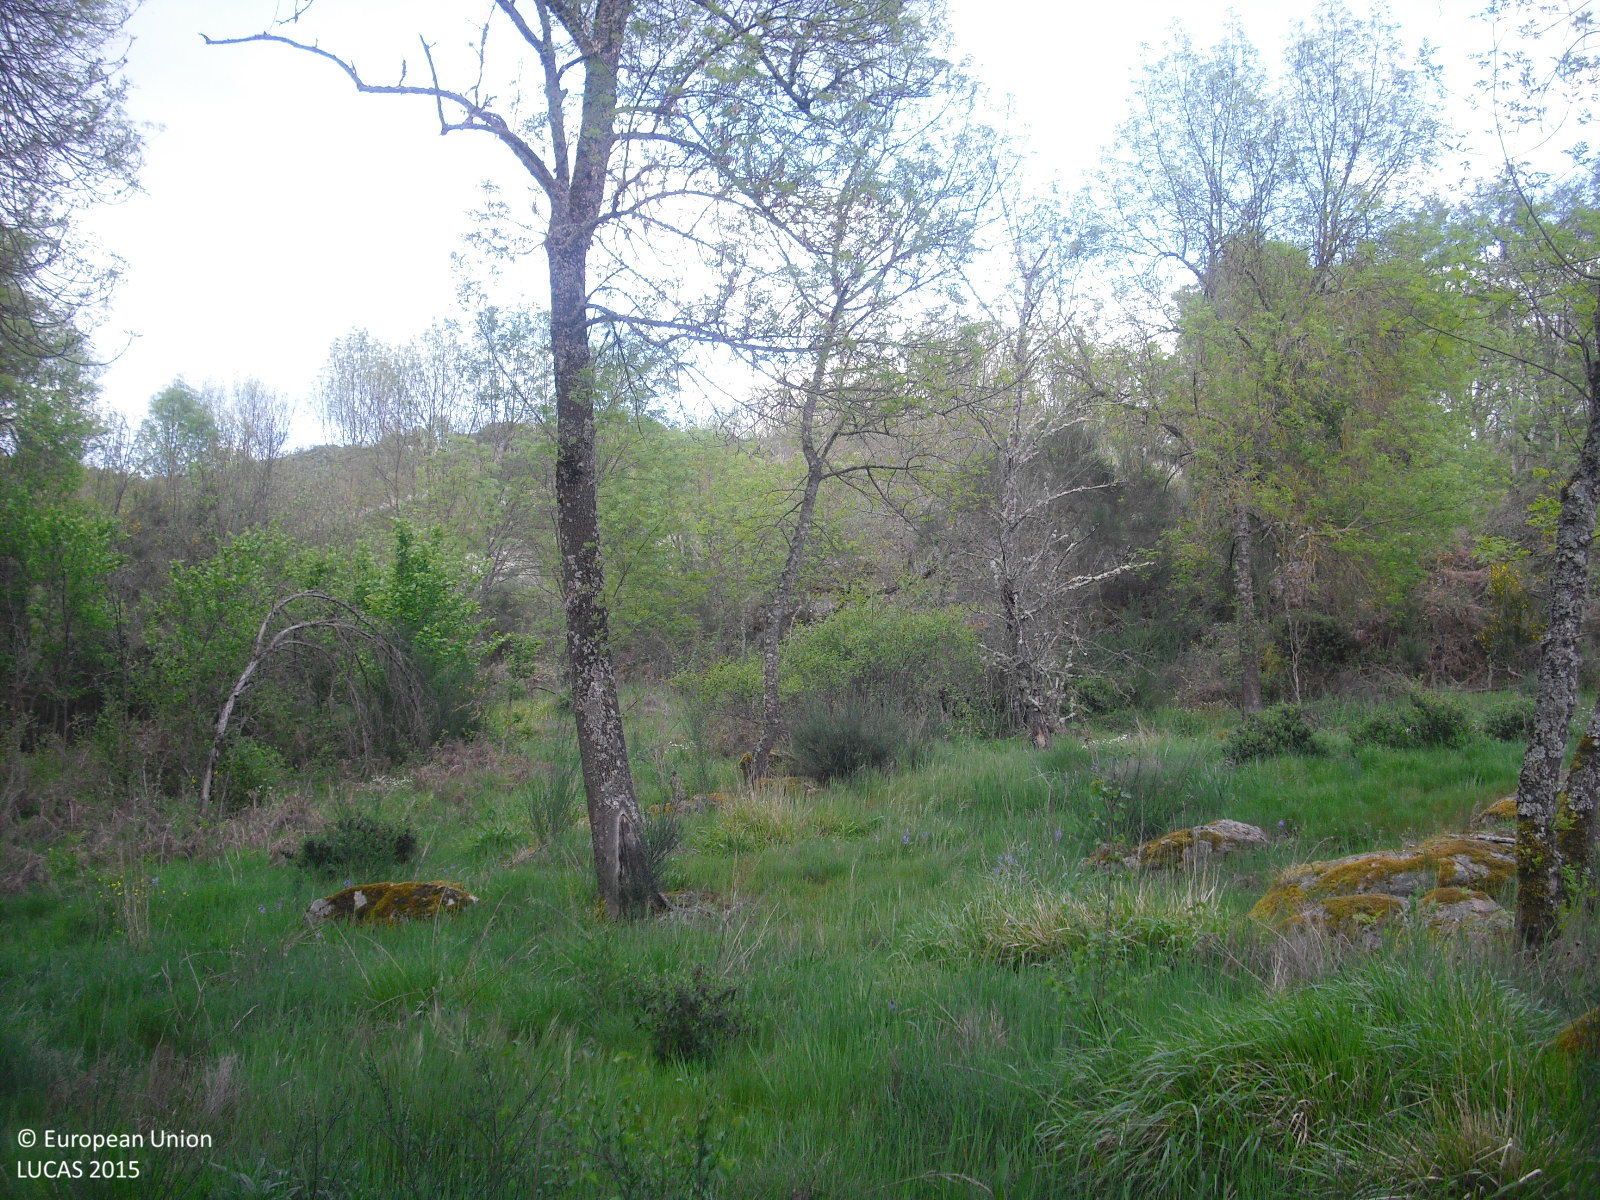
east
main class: Woodland
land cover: Broadleaved woodland
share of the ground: 25 - 50 %
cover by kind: broadleaved forest trees 30 %, herbaceous plants 30 %, shrubs 20 %, consolidated bare surface 20 %
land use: Amenities, museums, leisure
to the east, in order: Broadleaved woodland; Rock outcrops; Broadleaved woodland; Ditches and canals; Shrubland with sparse tree cover; Dry stone walls; Tracks; Single bushes/trees; Rock outcrops; Broadleaved woodland; Grassland without tree/shrub cover; Shrubland without tree cover; Rivers and streams; Grassland with sparse tree/shrub cover; Ditches and canals; Broadleaved woodland; Shrubland with sparse tree cover; Dry stone walls; Shrubland with sparse tree cover; Rock outcrops; Shrubland with sparse tree cover; Dry stone walls; Shrubland with sparse tree cover
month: April
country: ES
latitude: 41.8865
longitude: -7.5240
